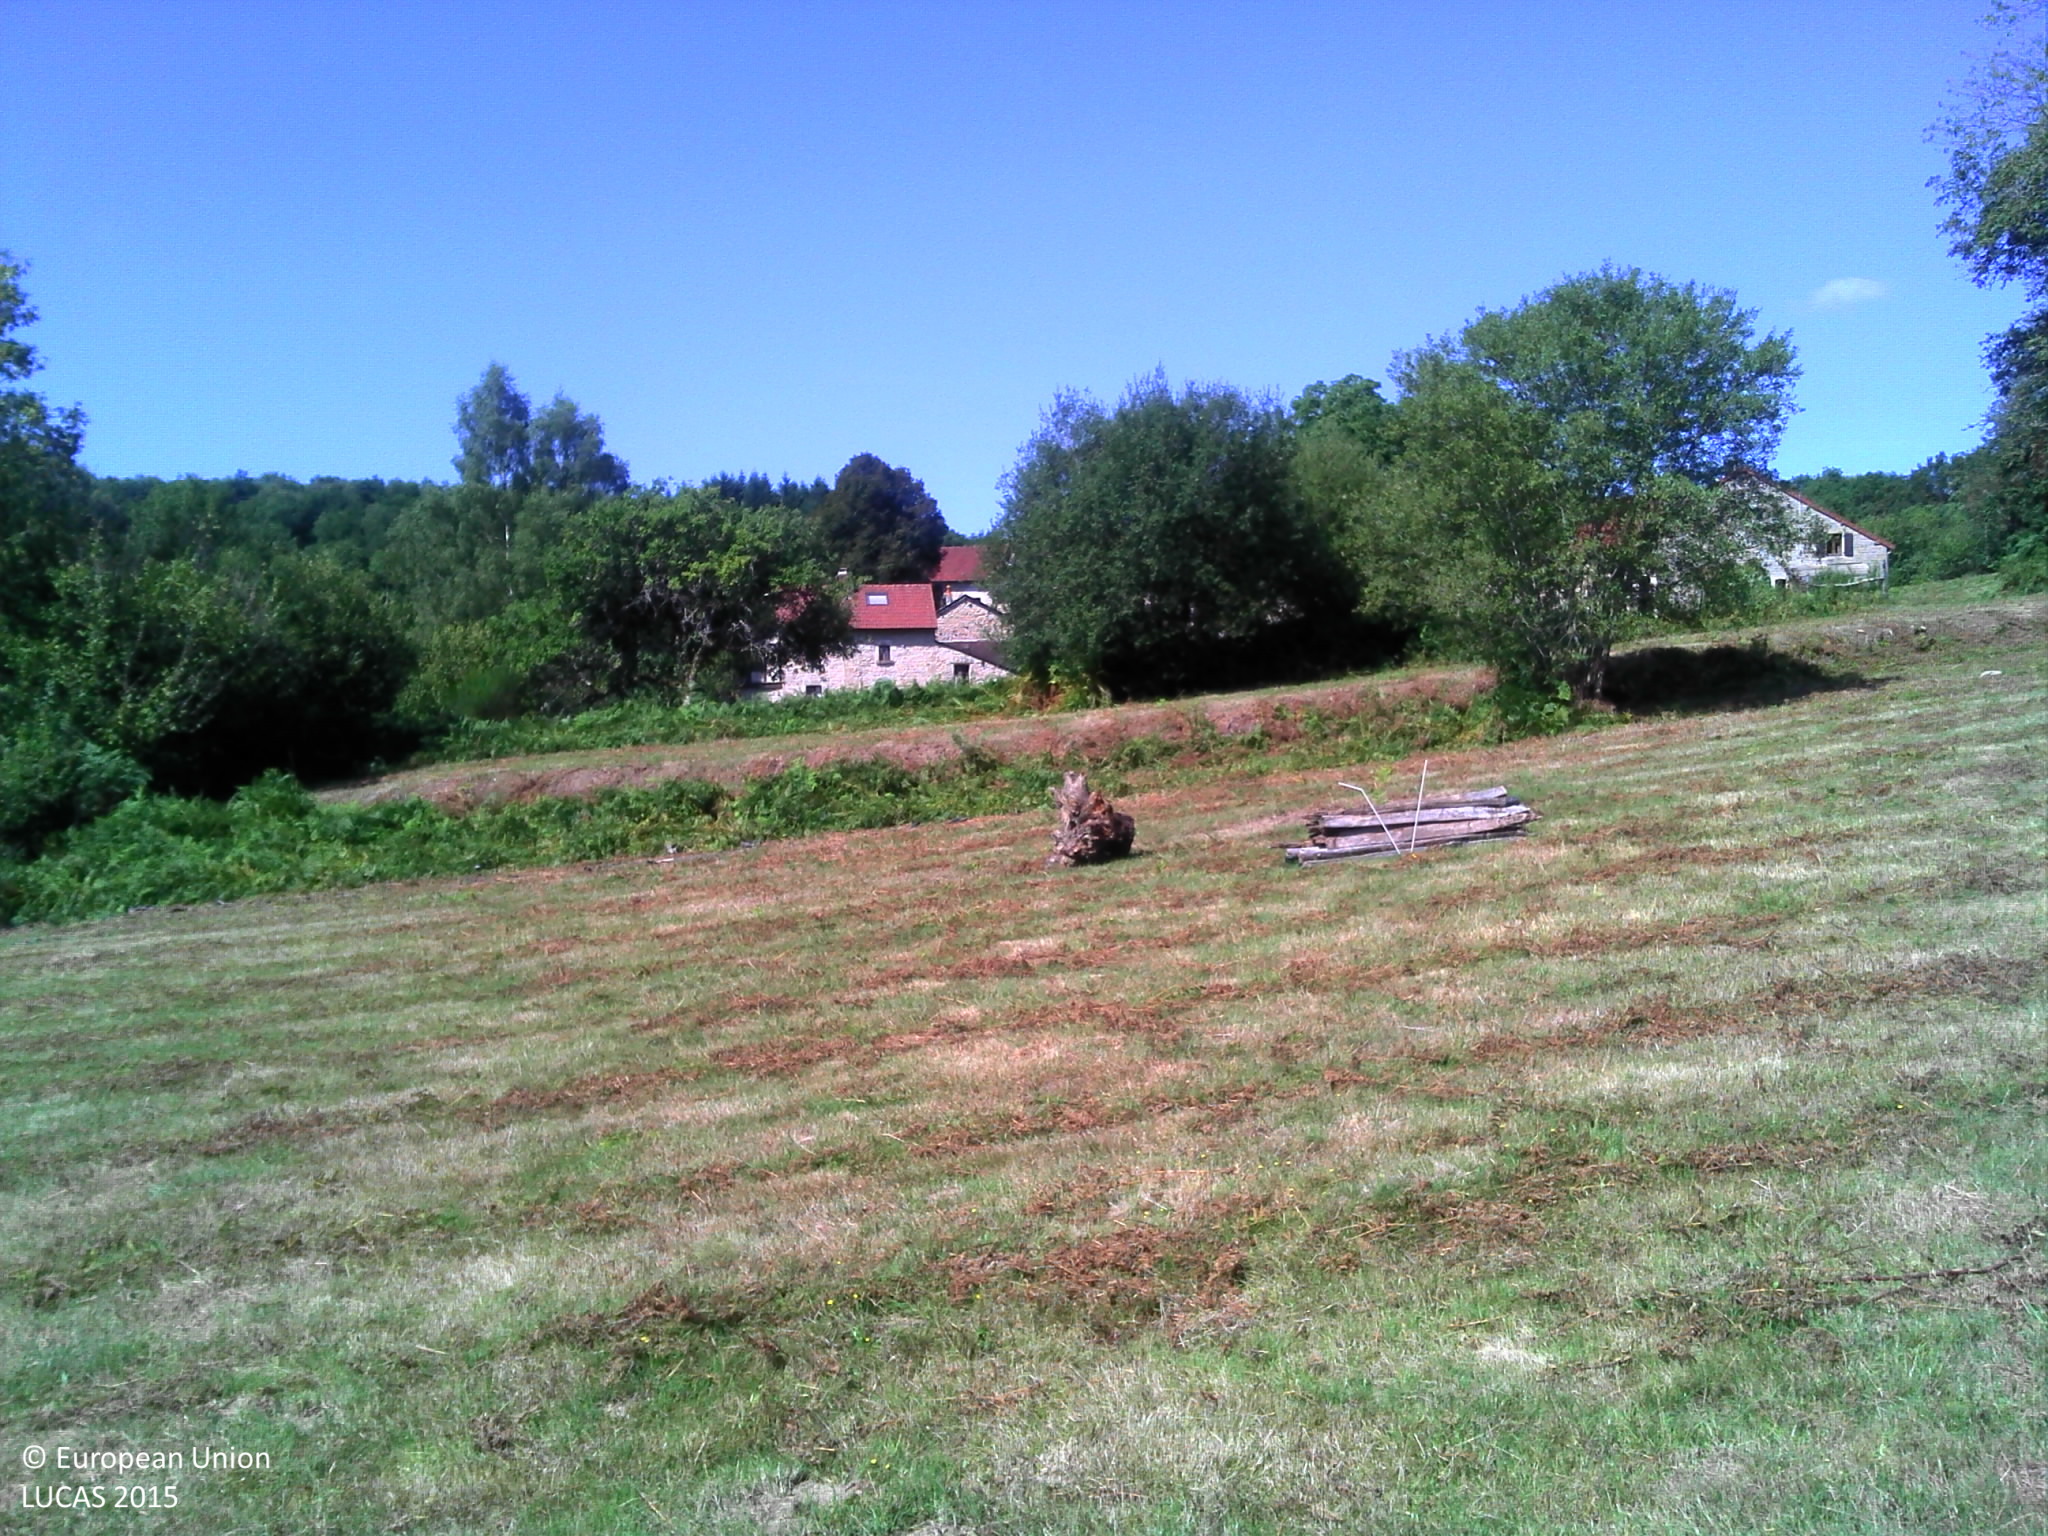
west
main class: Grassland
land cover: Grassland without tree/shrub cover
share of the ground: > 75 %
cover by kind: herbaceous plants 100 %
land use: Agriculture (excluding fallow land and kitchen gardens)
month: August
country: FR
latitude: 45.8204
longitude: 1.8211
